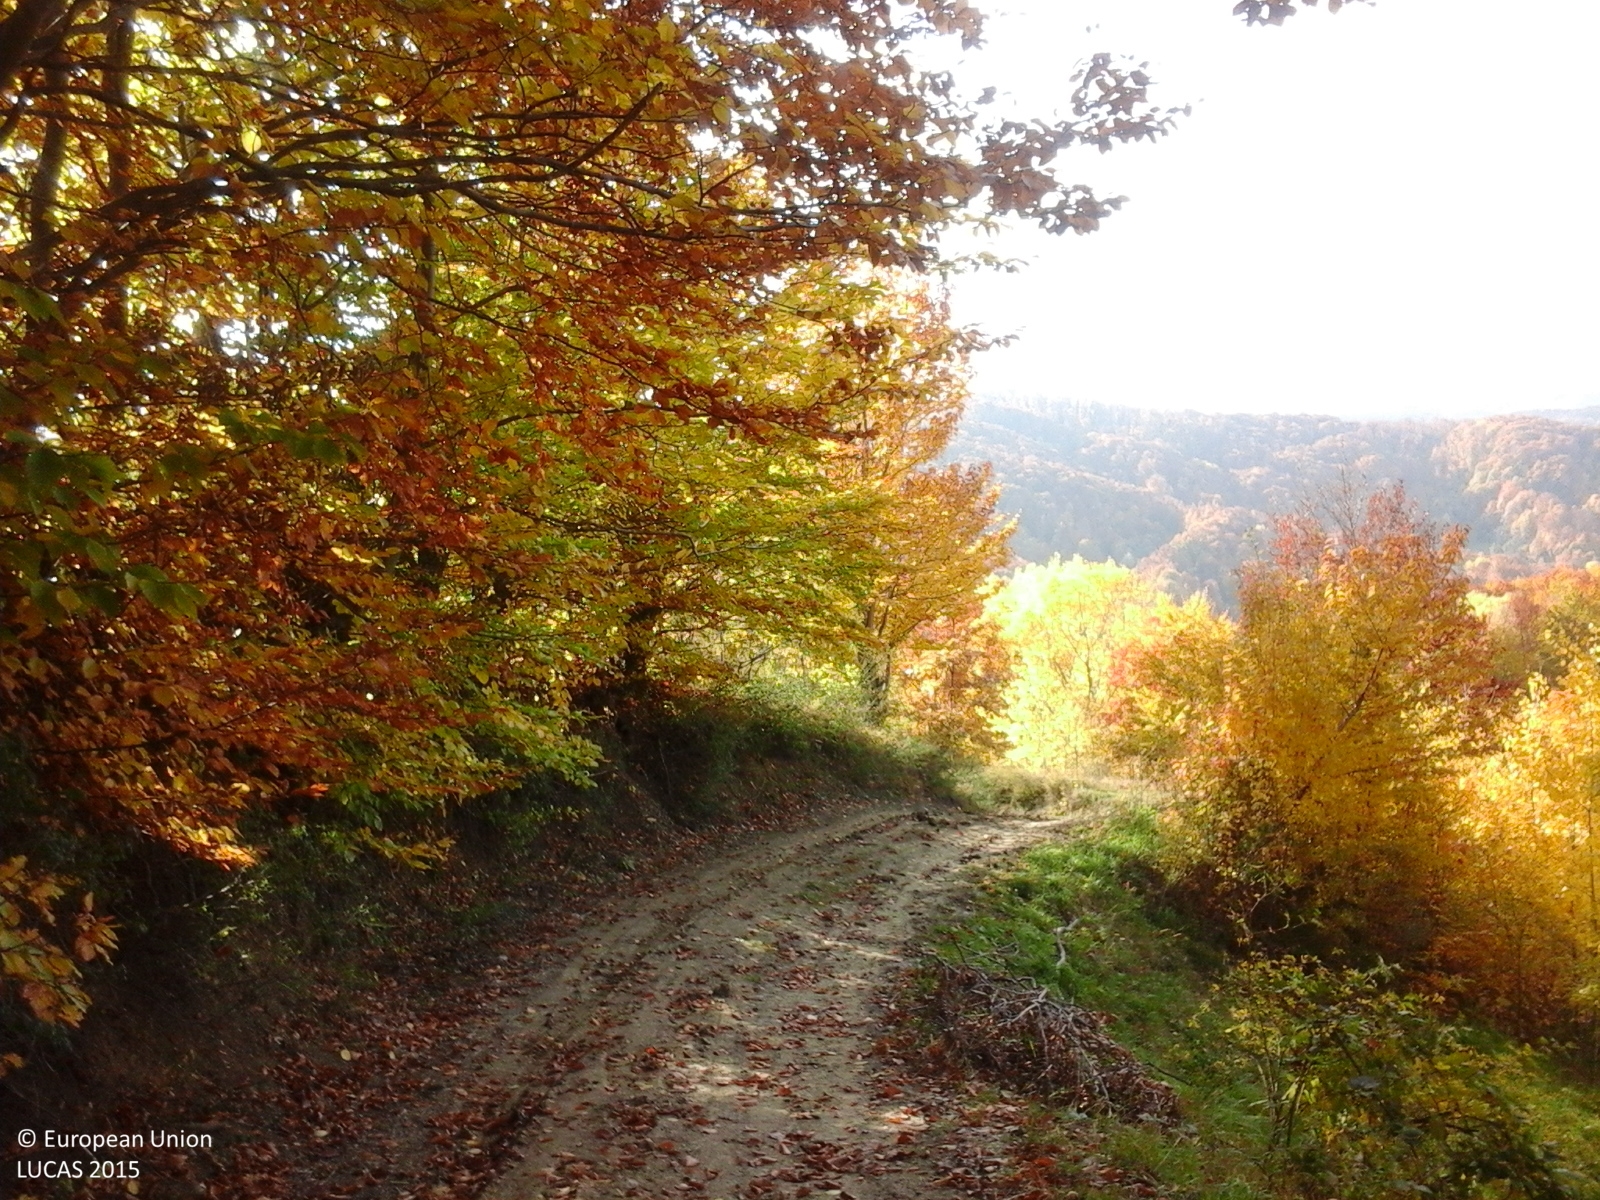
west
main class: Woodland
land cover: Broadleaved woodland
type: beech forest
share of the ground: > 75 %
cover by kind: broadleaved forest trees 100 %
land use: Forestry
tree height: > 5 m
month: October
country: RO
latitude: 45.6058
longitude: 26.8687
